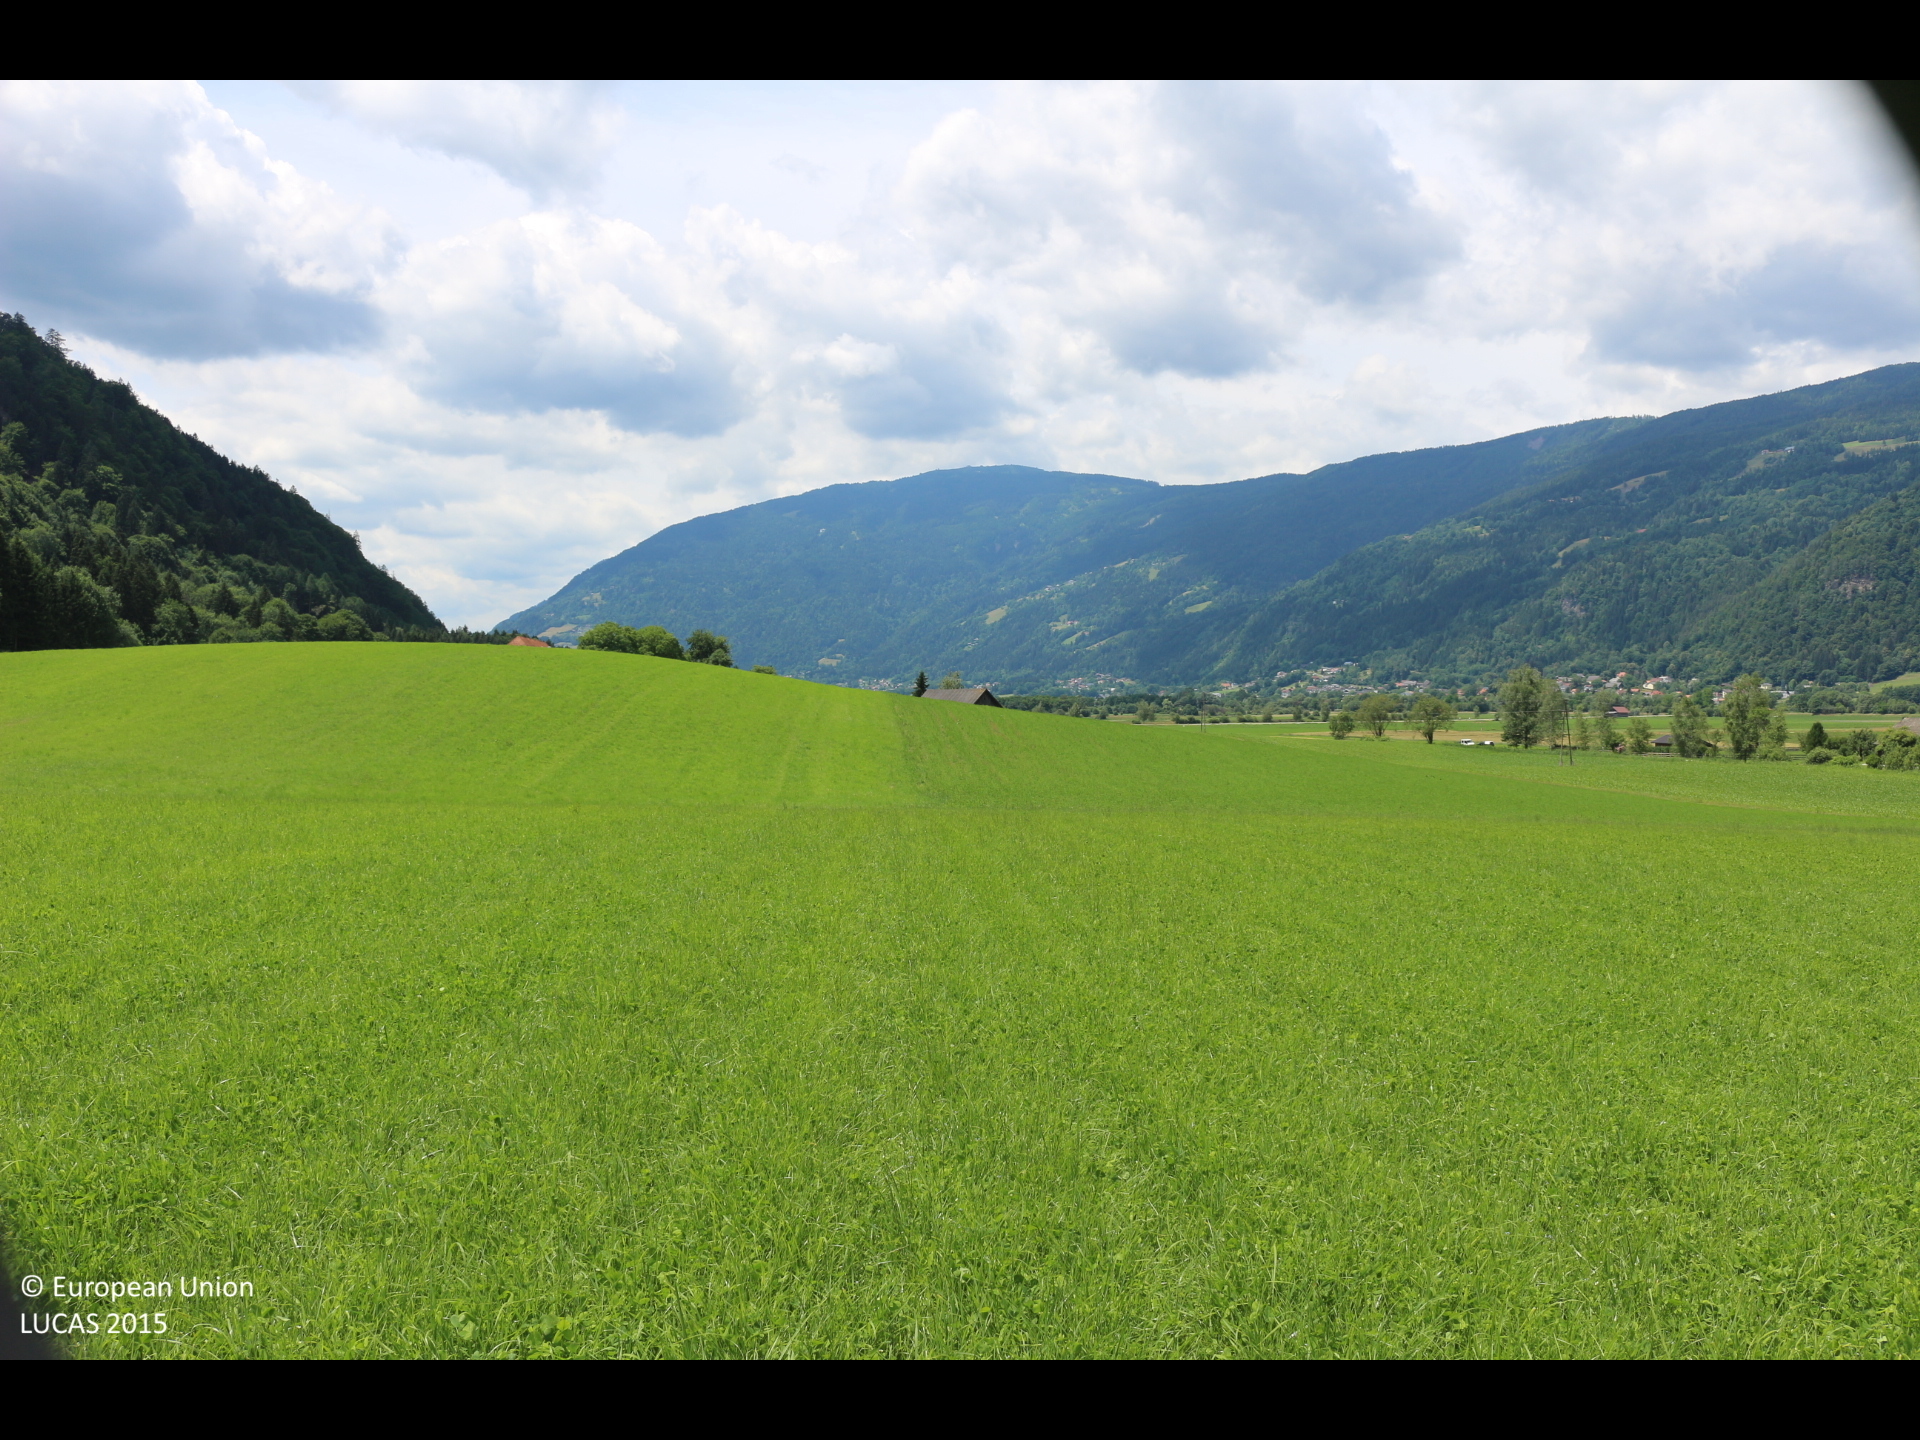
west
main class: Cropland
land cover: Temporary grasslands
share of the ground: > 75 %
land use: Agriculture (excluding fallow land and kitchen gardens)
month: June
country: AT
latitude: 46.6897
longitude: 14.0378
